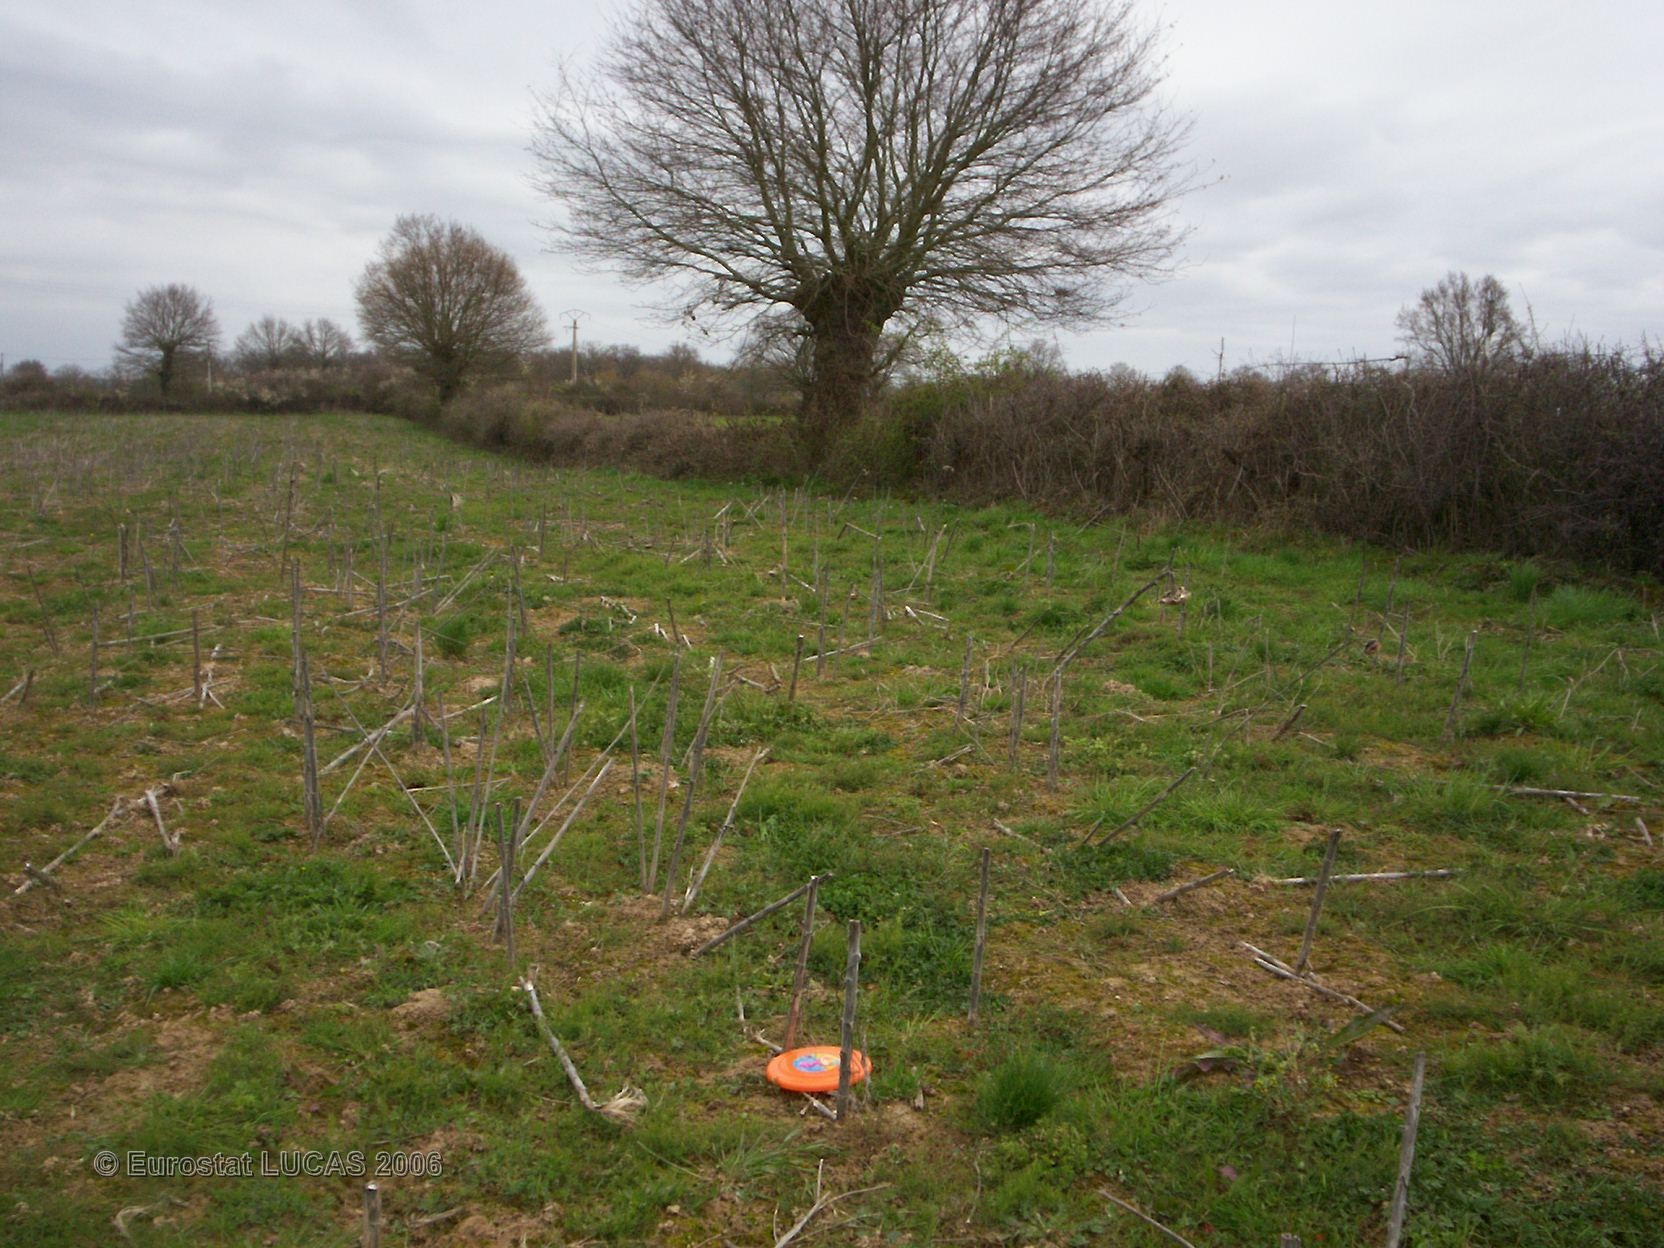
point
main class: Grassland
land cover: Grassland without tree/shrub cover
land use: Fallow land
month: April
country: FR
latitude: 46.7052
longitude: 3.0778
